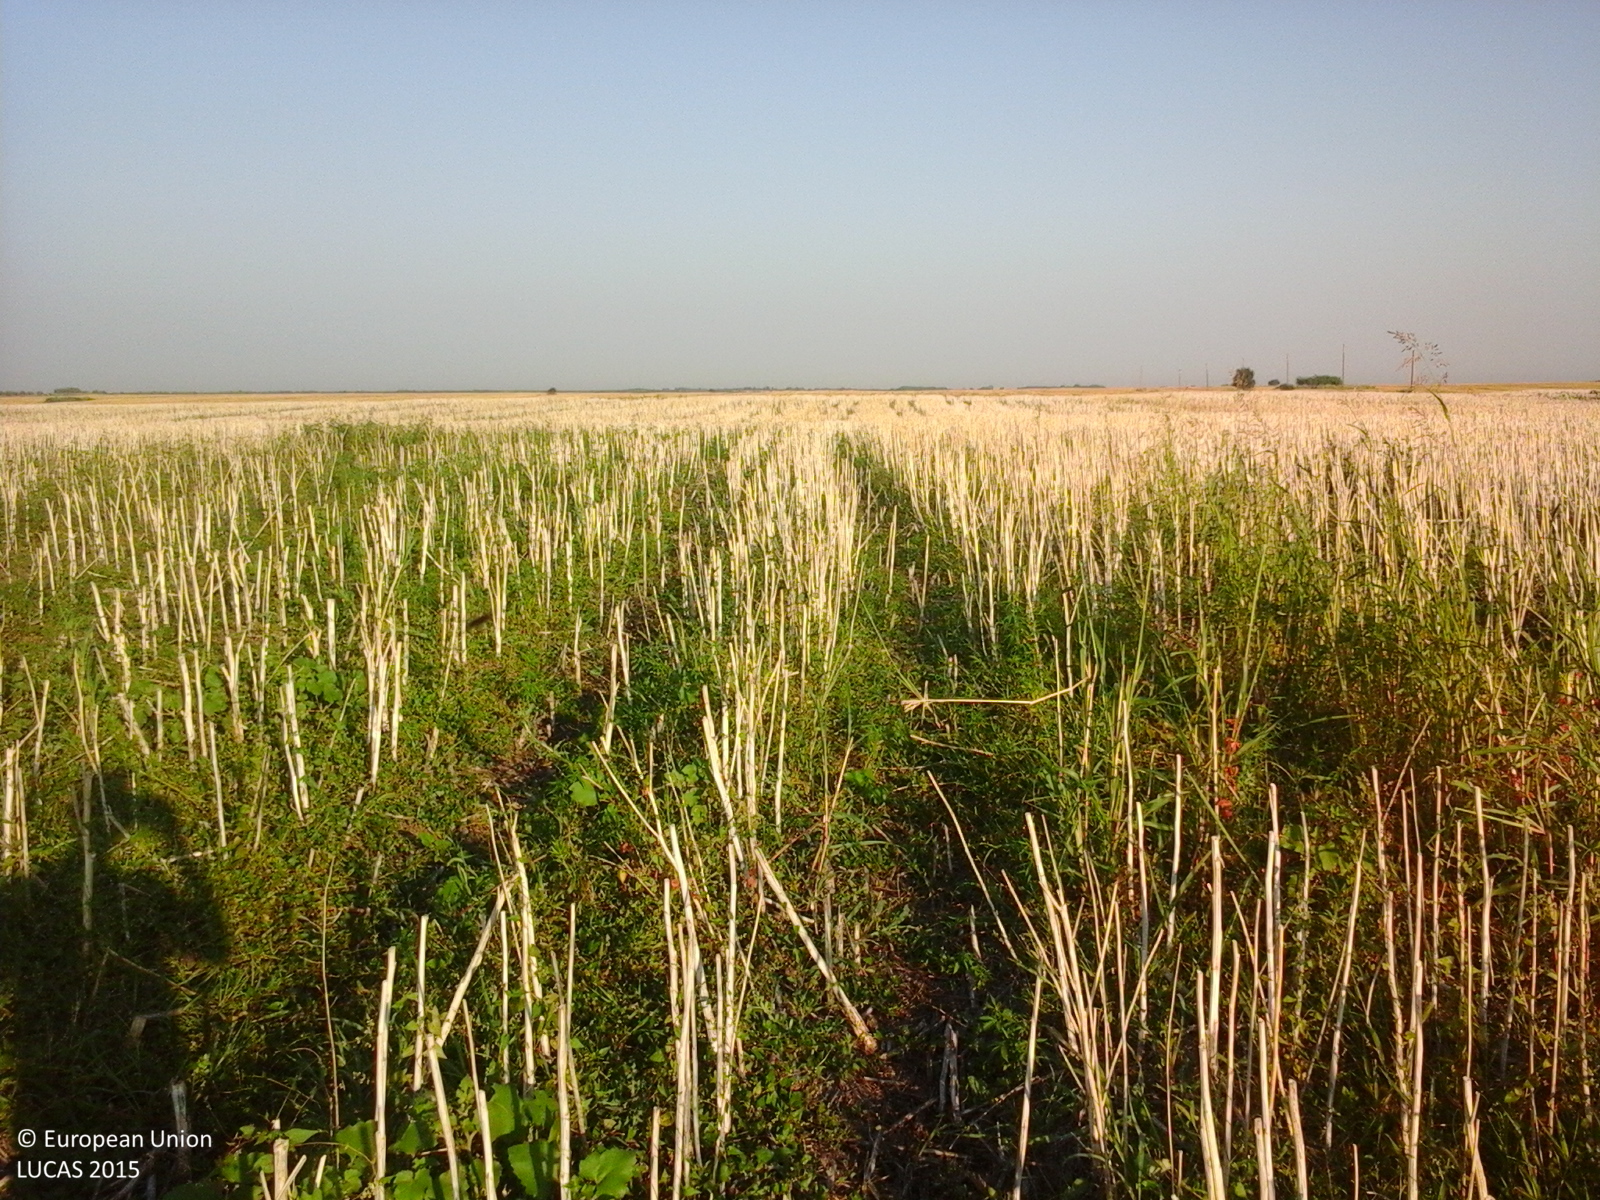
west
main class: Cropland
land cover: Rape and turnip rape
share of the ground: < 10 %
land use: Agriculture (excluding fallow land and kitchen gardens)
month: July
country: RO
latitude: 44.5239
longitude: 27.1830
